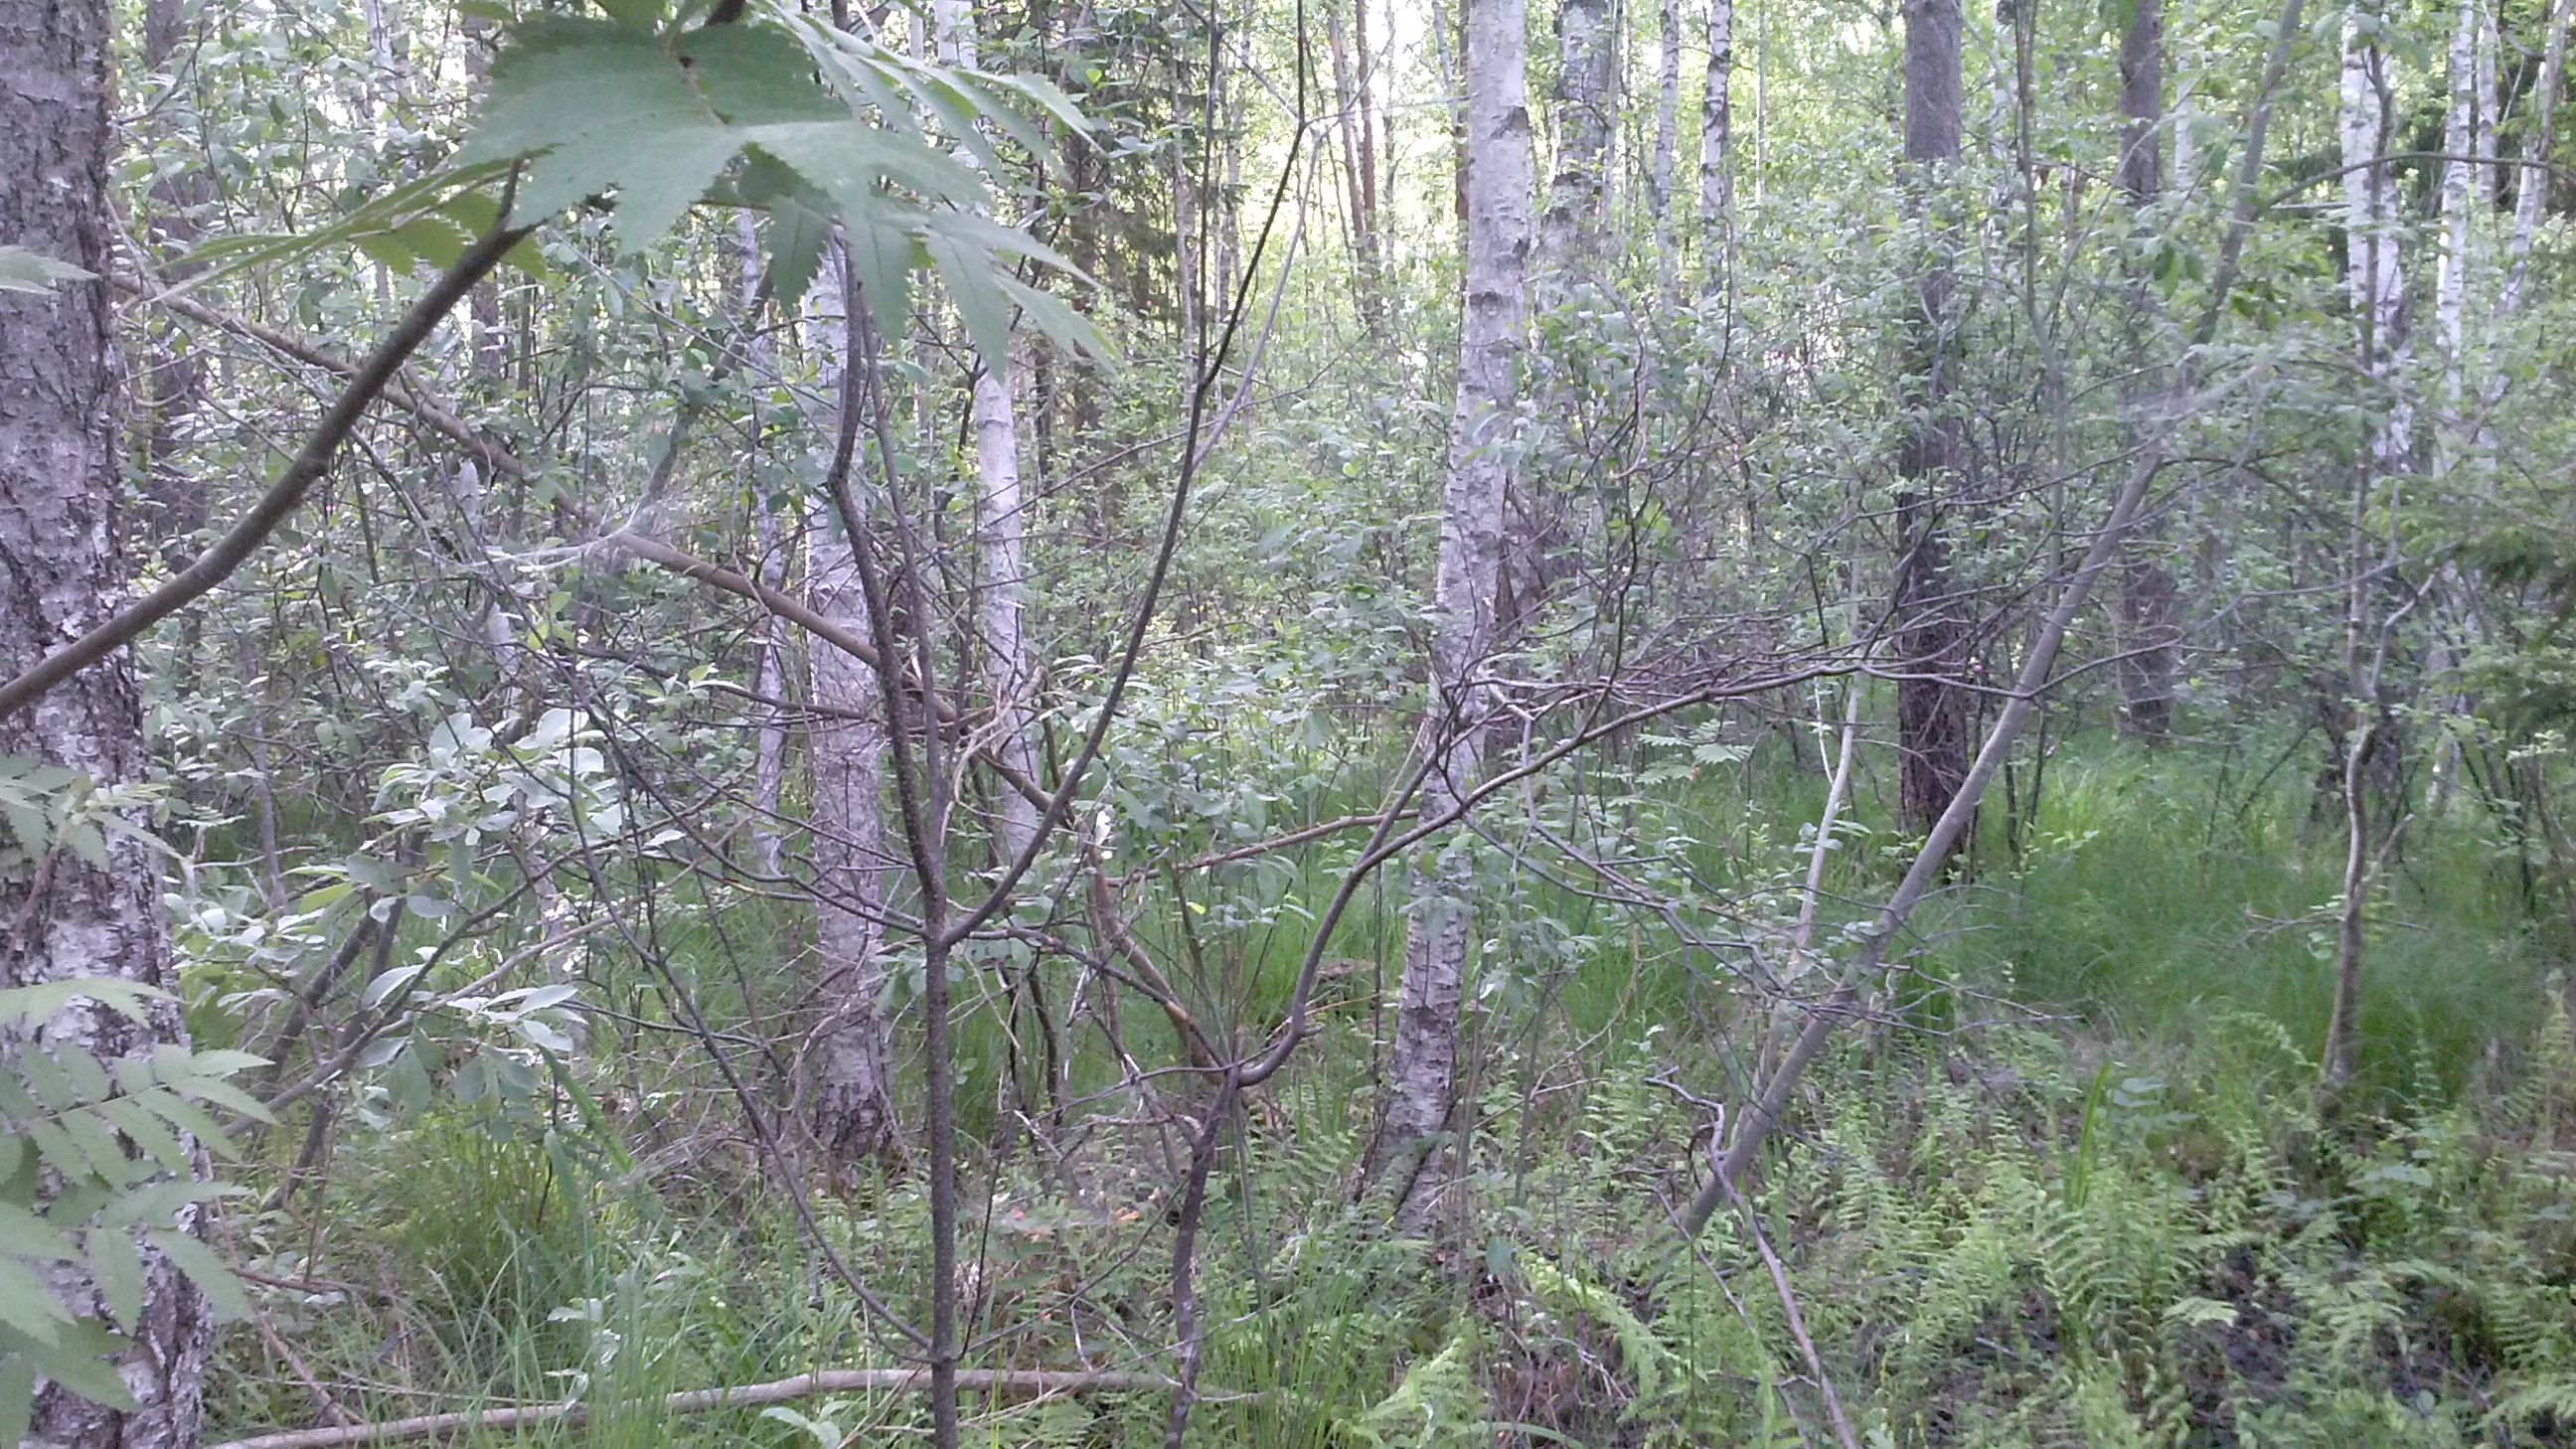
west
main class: Woodland
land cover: Broadleaved woodland
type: non-riverine alder, birch or aspen forest
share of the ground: > 75 %
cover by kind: broadleaved forest trees 85 %, coniferous forest trees 5 %, shrubs 5 %, herbaceous plants 5 %
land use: Forestry
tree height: > 5 m
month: June
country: LV
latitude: 56.3835
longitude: 27.4258
